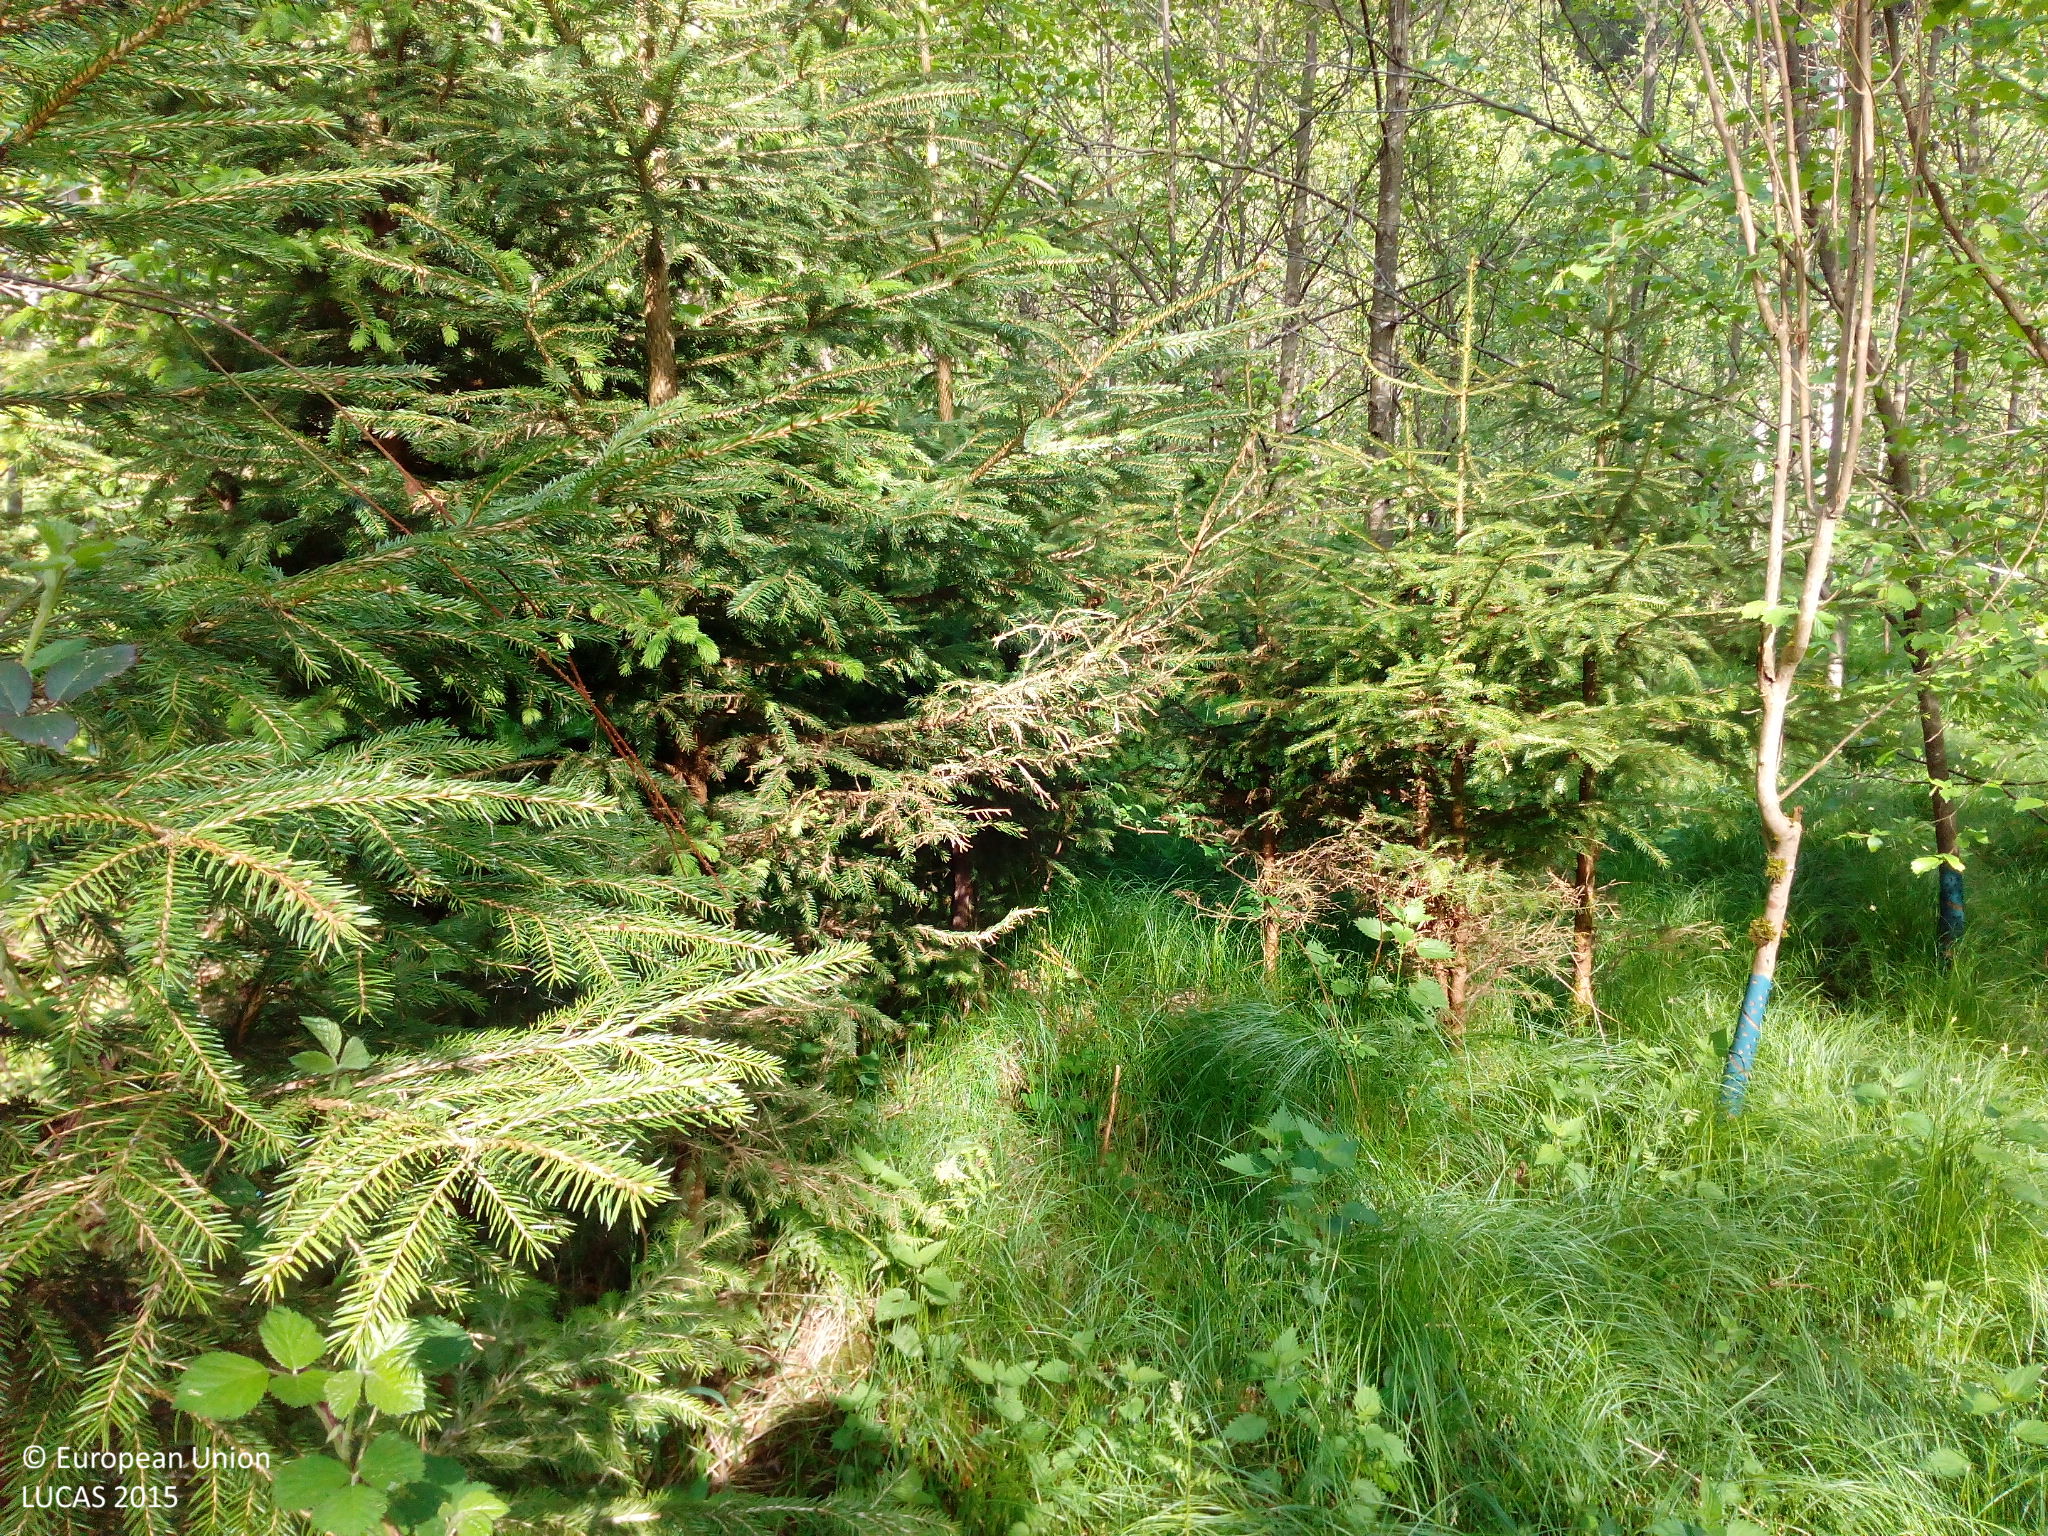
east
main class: Woodland
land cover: Broadleaved woodland
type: mesophytic deciduous forest
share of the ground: 50 - 75 %
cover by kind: broadleaved forest trees 45 %, shrubs 30 %, herbaceous plants 15 %, coniferous forest trees 10 %
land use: Forestry
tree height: > 5 m
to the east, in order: Broadleaved woodland; Ditches and canals; Grassland with sparse tree/shrub cover; Ditches and canals; Broadleaved woodland; Inland marshes; Ditches and canals; Spruce dominated coniferous woodland; Tracks; Spruce dominated coniferous woodland; Ditches and canals; Spruce dominated coniferous woodland
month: May
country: DE
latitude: 47.9866
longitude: 9.1832
